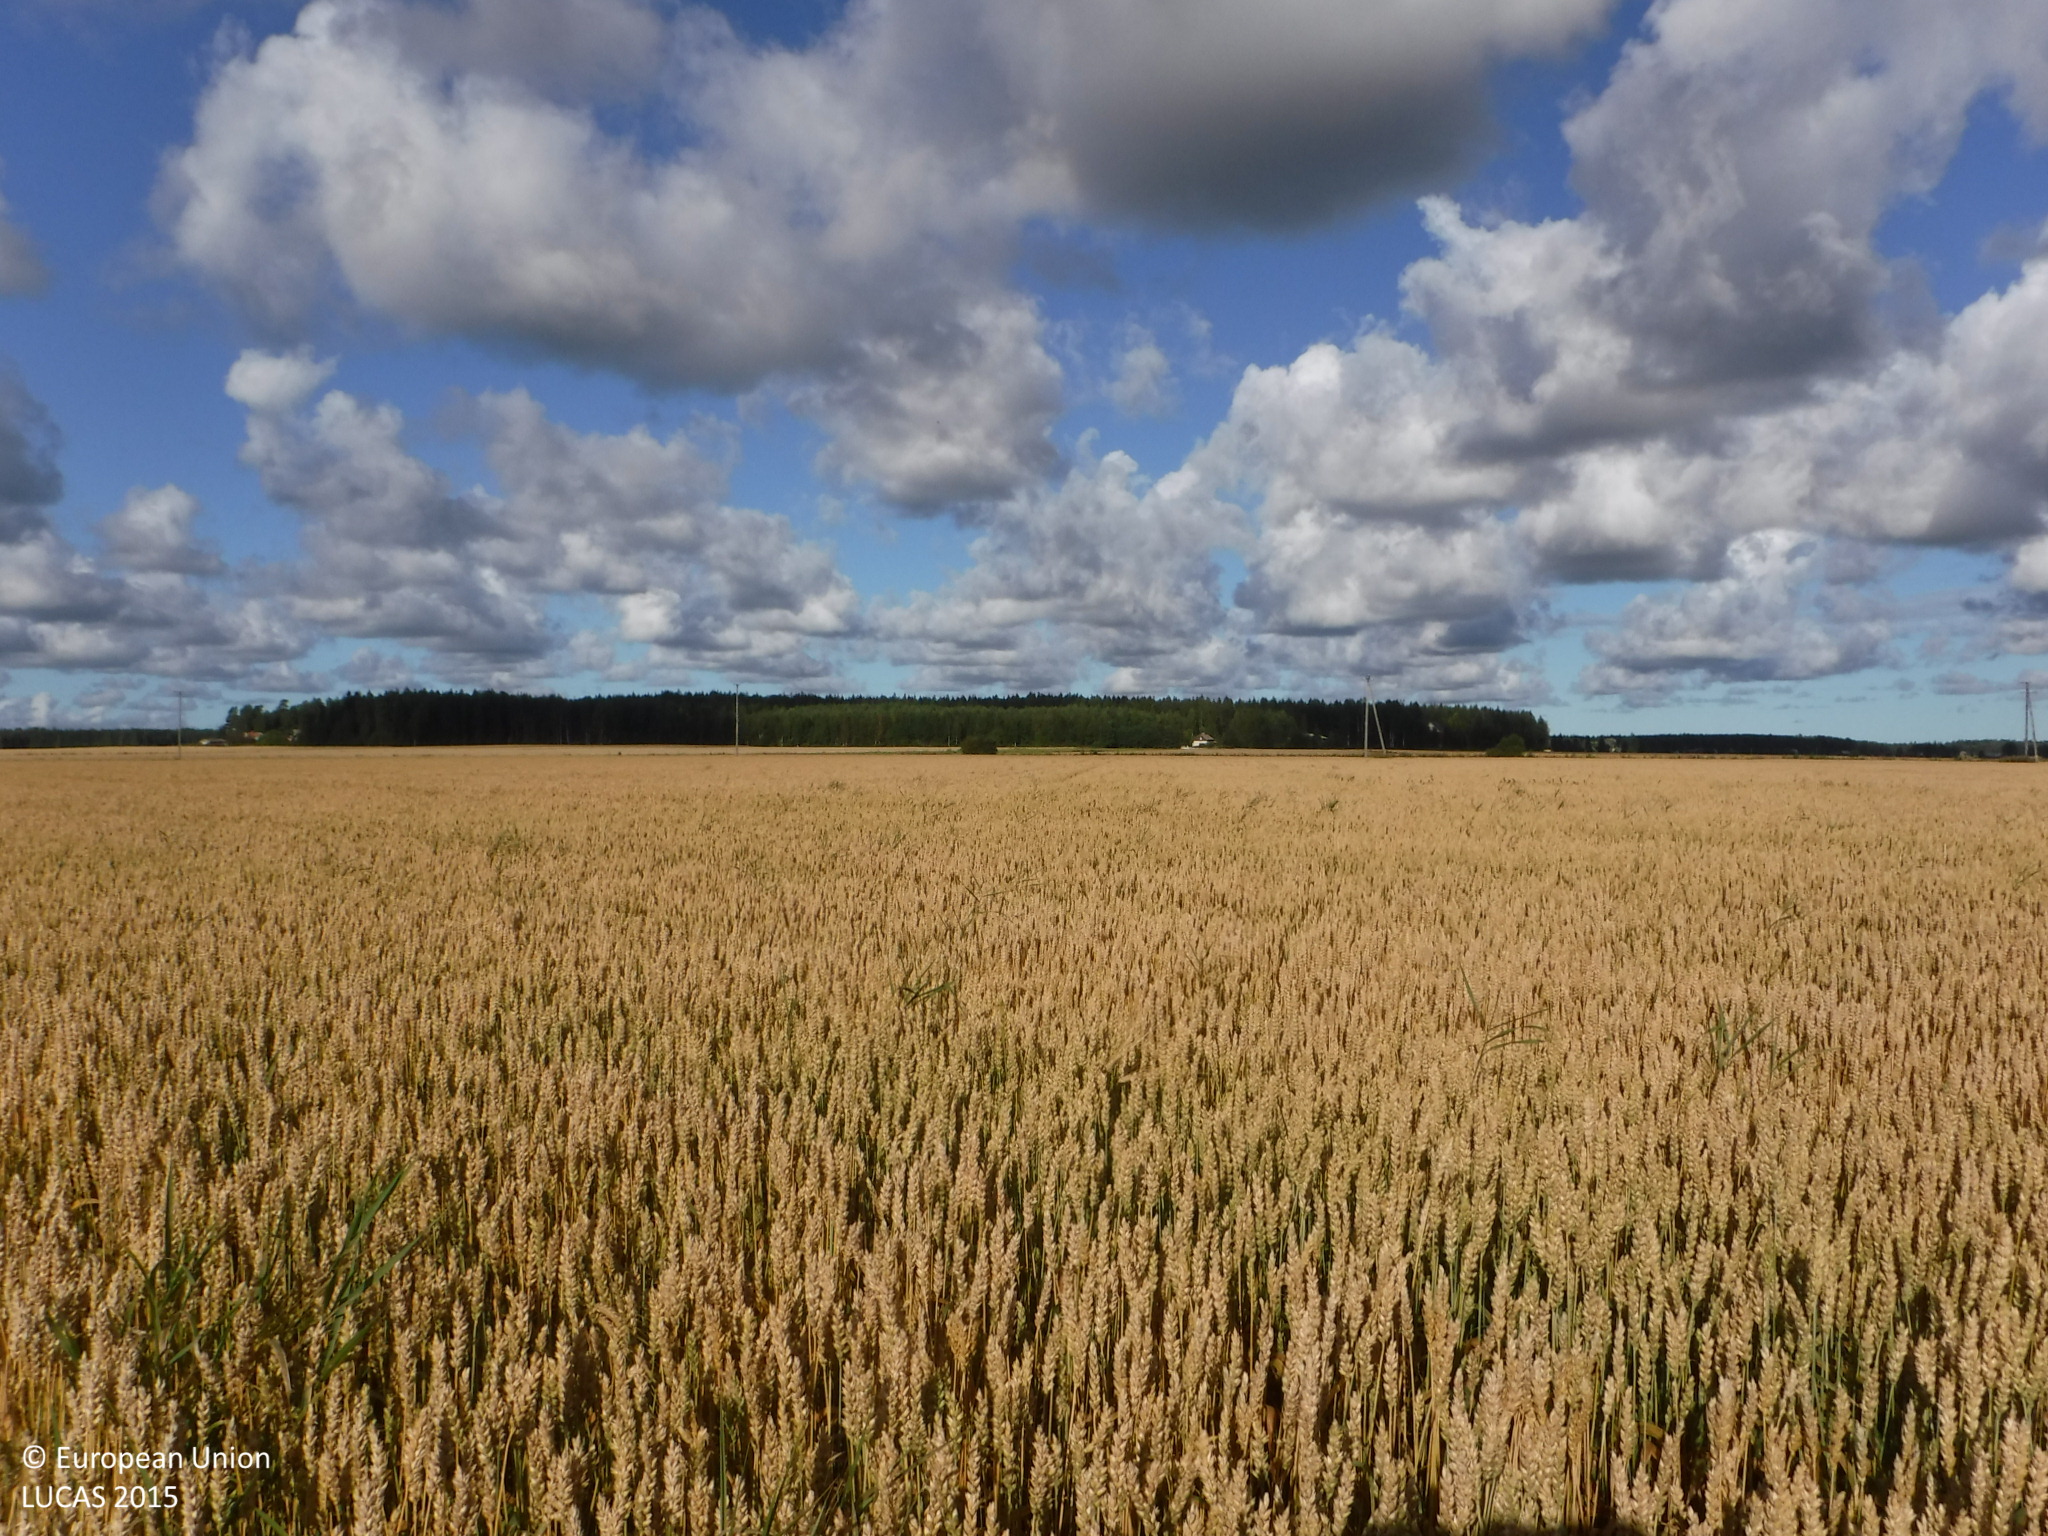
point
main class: Cropland
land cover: Common wheat
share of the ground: > 75 %
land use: Agriculture (excluding fallow land and kitchen gardens)
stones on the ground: < 10 %
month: August
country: FI
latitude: 61.3271
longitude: 21.9963
